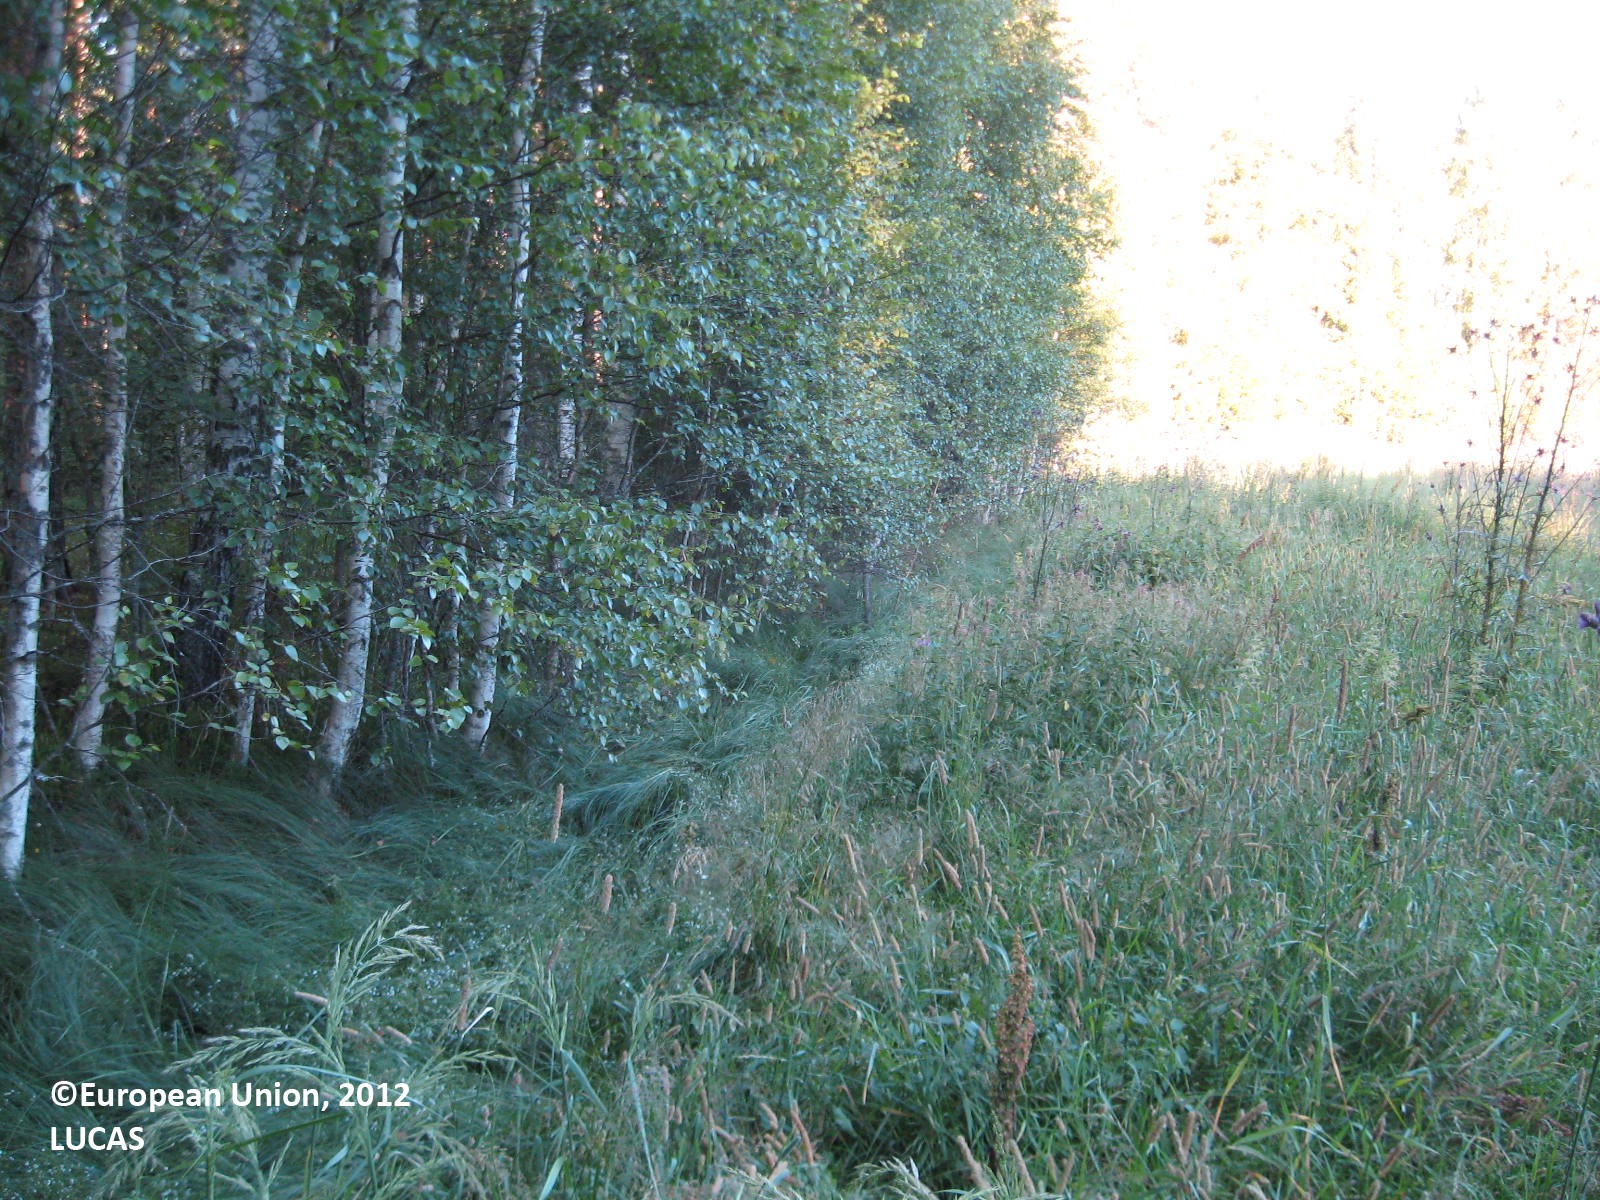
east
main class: Grassland
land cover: Spontaneously vegetated surfaces
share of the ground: > 75 %
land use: Abandoned areas
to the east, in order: Spontaneously vegetated surfaces; Grassland without tree/shrub cover; Ditches and canals; Other mixed woodland; Pine dominated mixed woodland
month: July
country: FI
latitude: 61.8613
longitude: 22.1639
